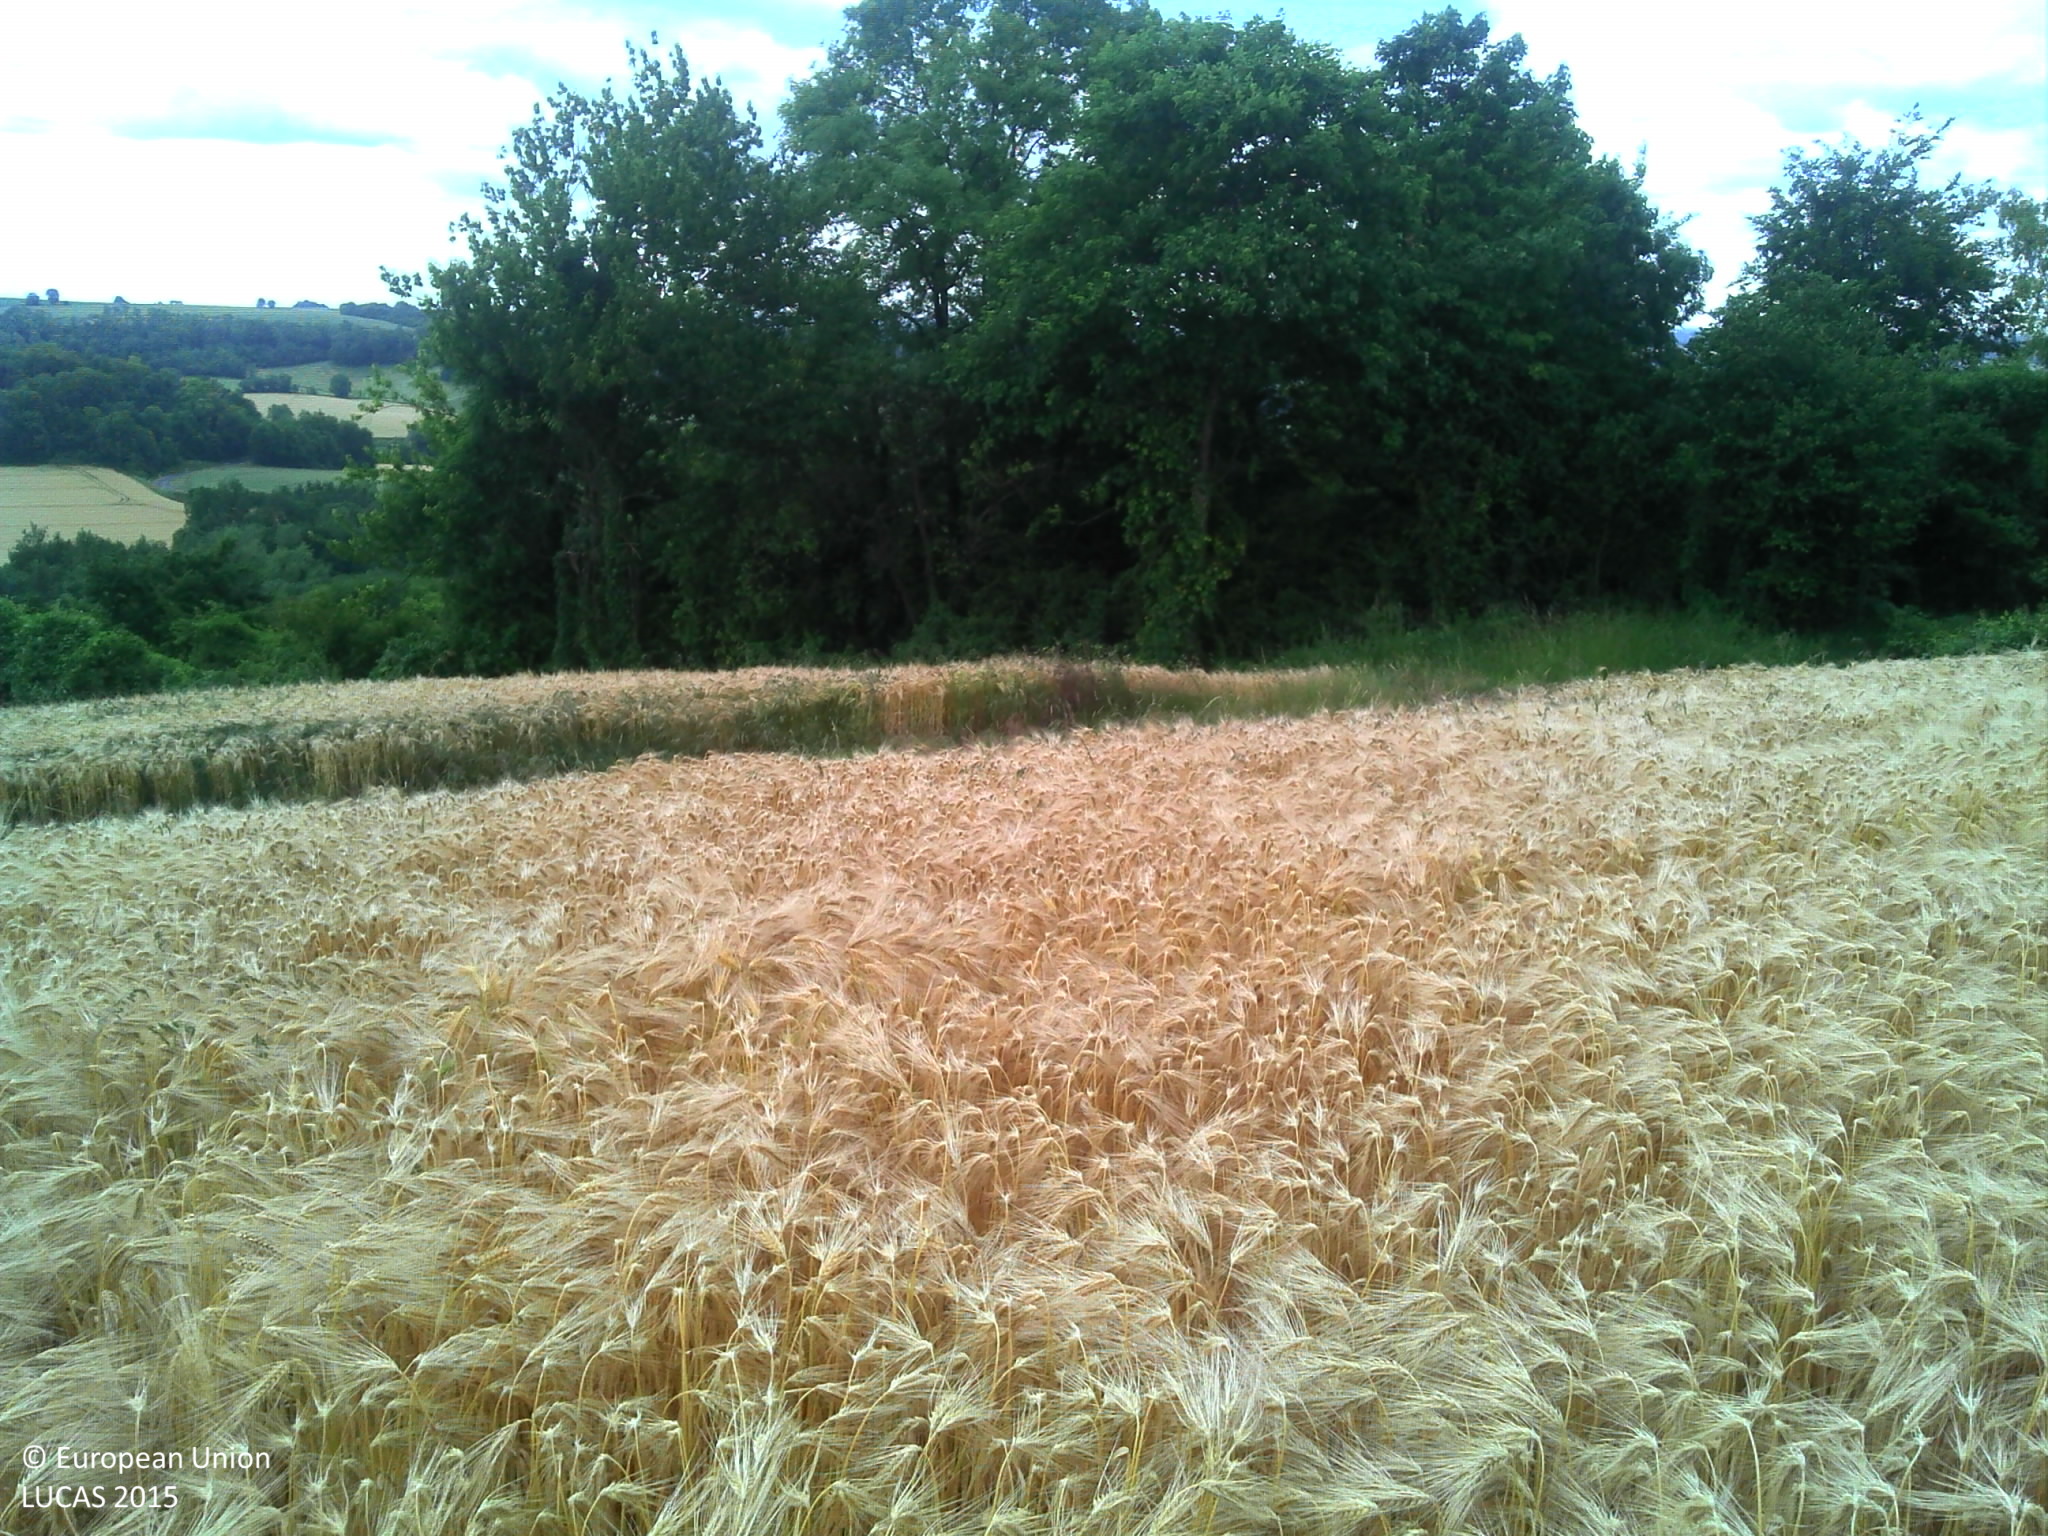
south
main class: Cropland
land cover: Barley
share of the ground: > 75 %
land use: Agriculture (excluding fallow land and kitchen gardens)
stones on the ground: < 10 %
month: June
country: FR
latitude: 49.4323
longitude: 3.6921
